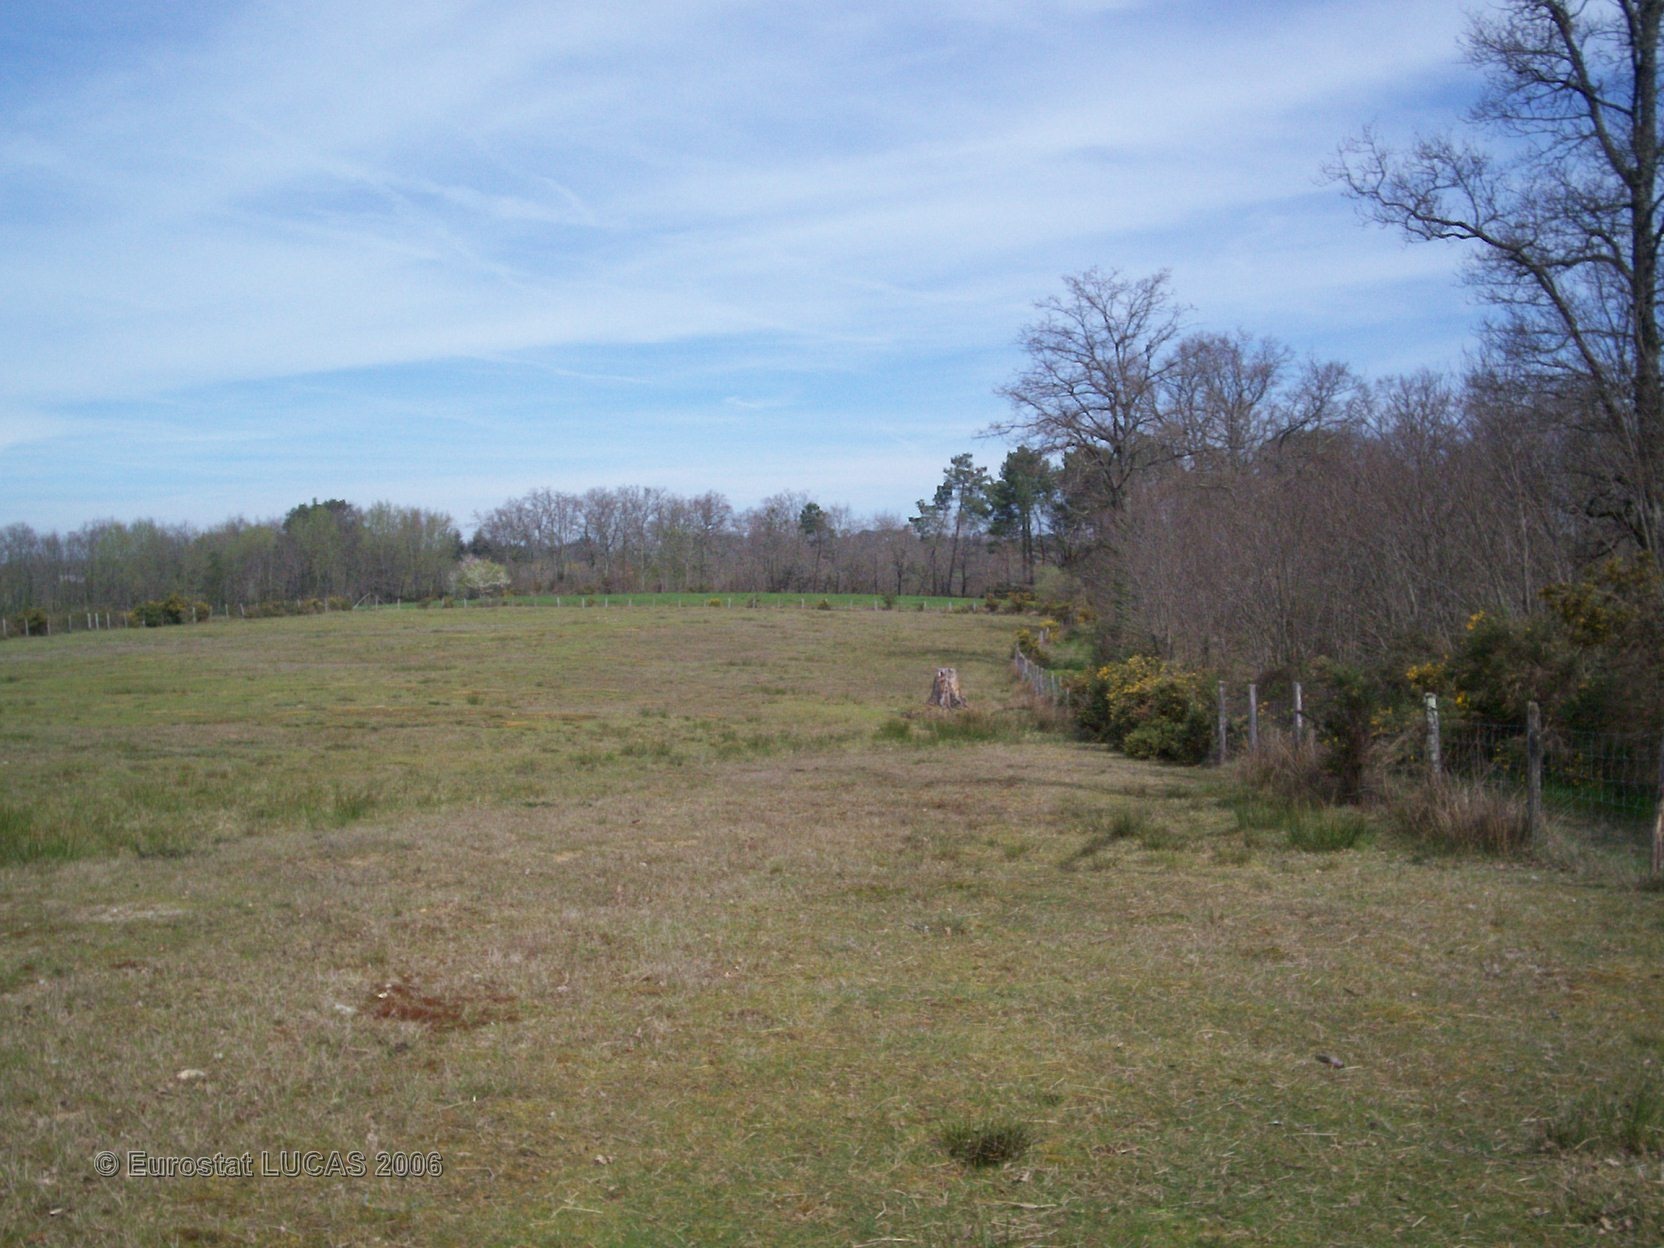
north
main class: Grassland
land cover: Grassland without tree/shrub cover
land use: Agriculture (excluding fallow land and kitchen gardens)
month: April
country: FR
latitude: 45.1811
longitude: 1.3020
